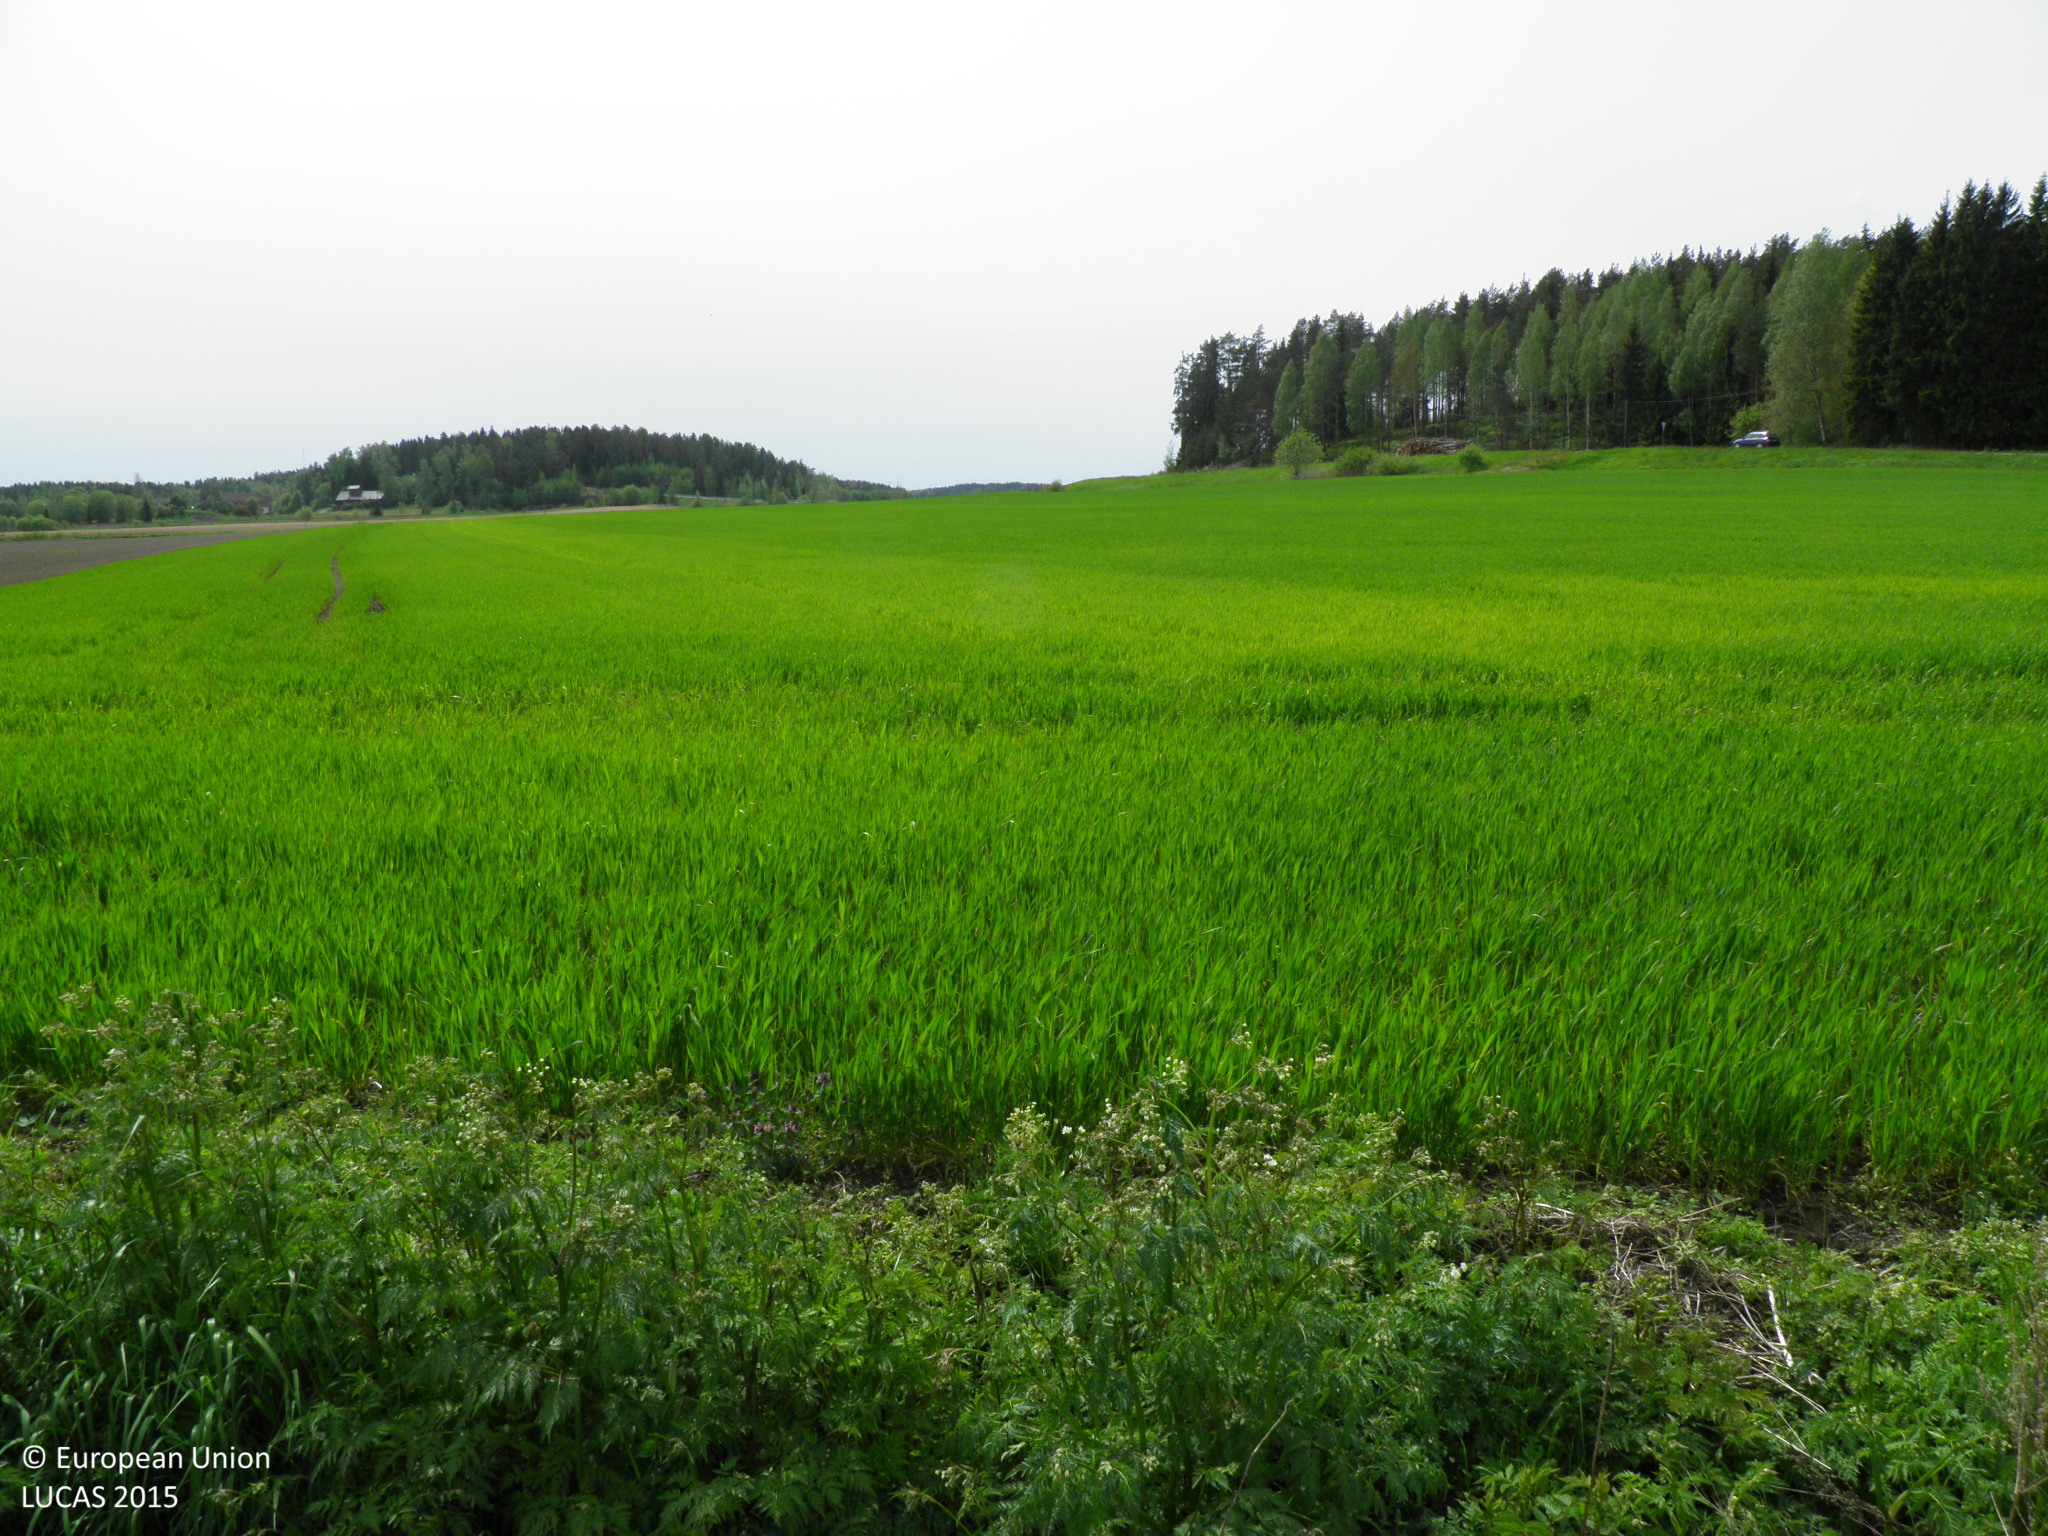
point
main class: Cropland
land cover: Common wheat
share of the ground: > 75 %
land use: Agriculture (excluding fallow land and kitchen gardens)
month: June
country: FI
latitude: 60.4678
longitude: 22.6401
